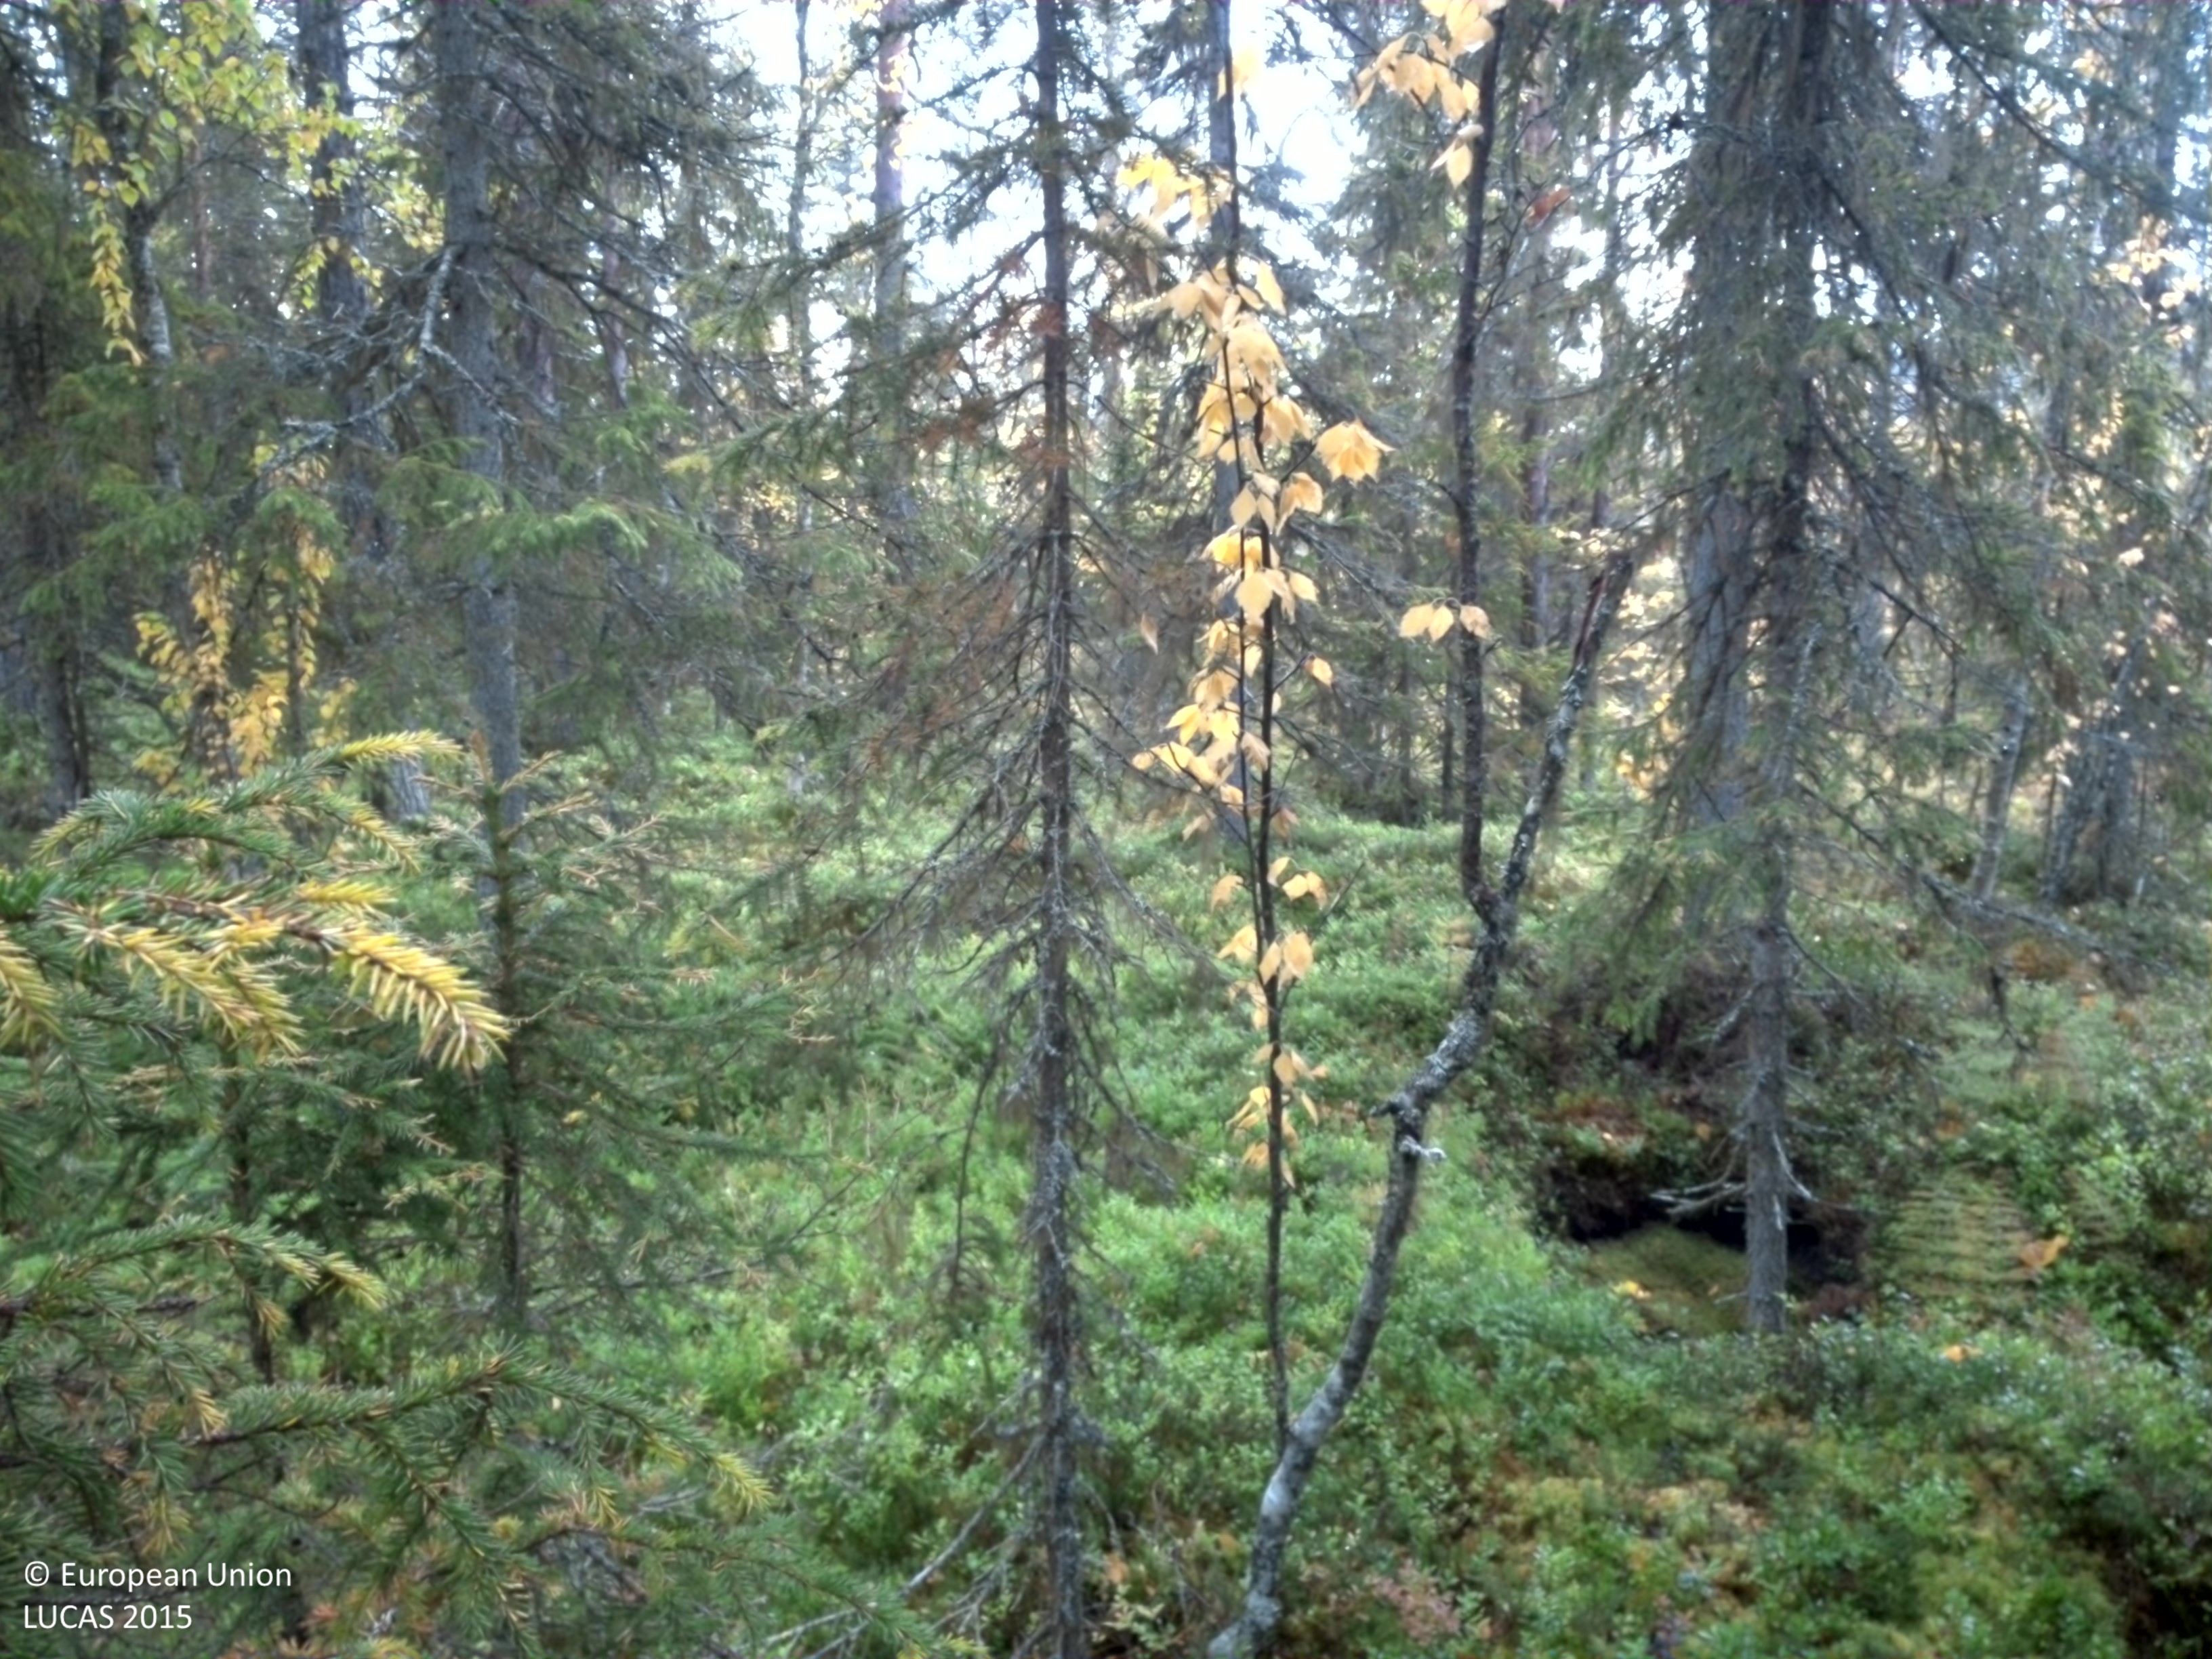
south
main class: Woodland
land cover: Spruce dominated mixed woodland
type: boreal forest
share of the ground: 50 - 75 %
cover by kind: coniferous forest trees 35 %, lichens and mosses 25 %, shrubs 20 %, broadleaved forest trees 15 %, herbaceous plants 5 %
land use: Forestry
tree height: > 5 m
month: September
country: SE
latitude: 65.2394
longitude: 16.6178
